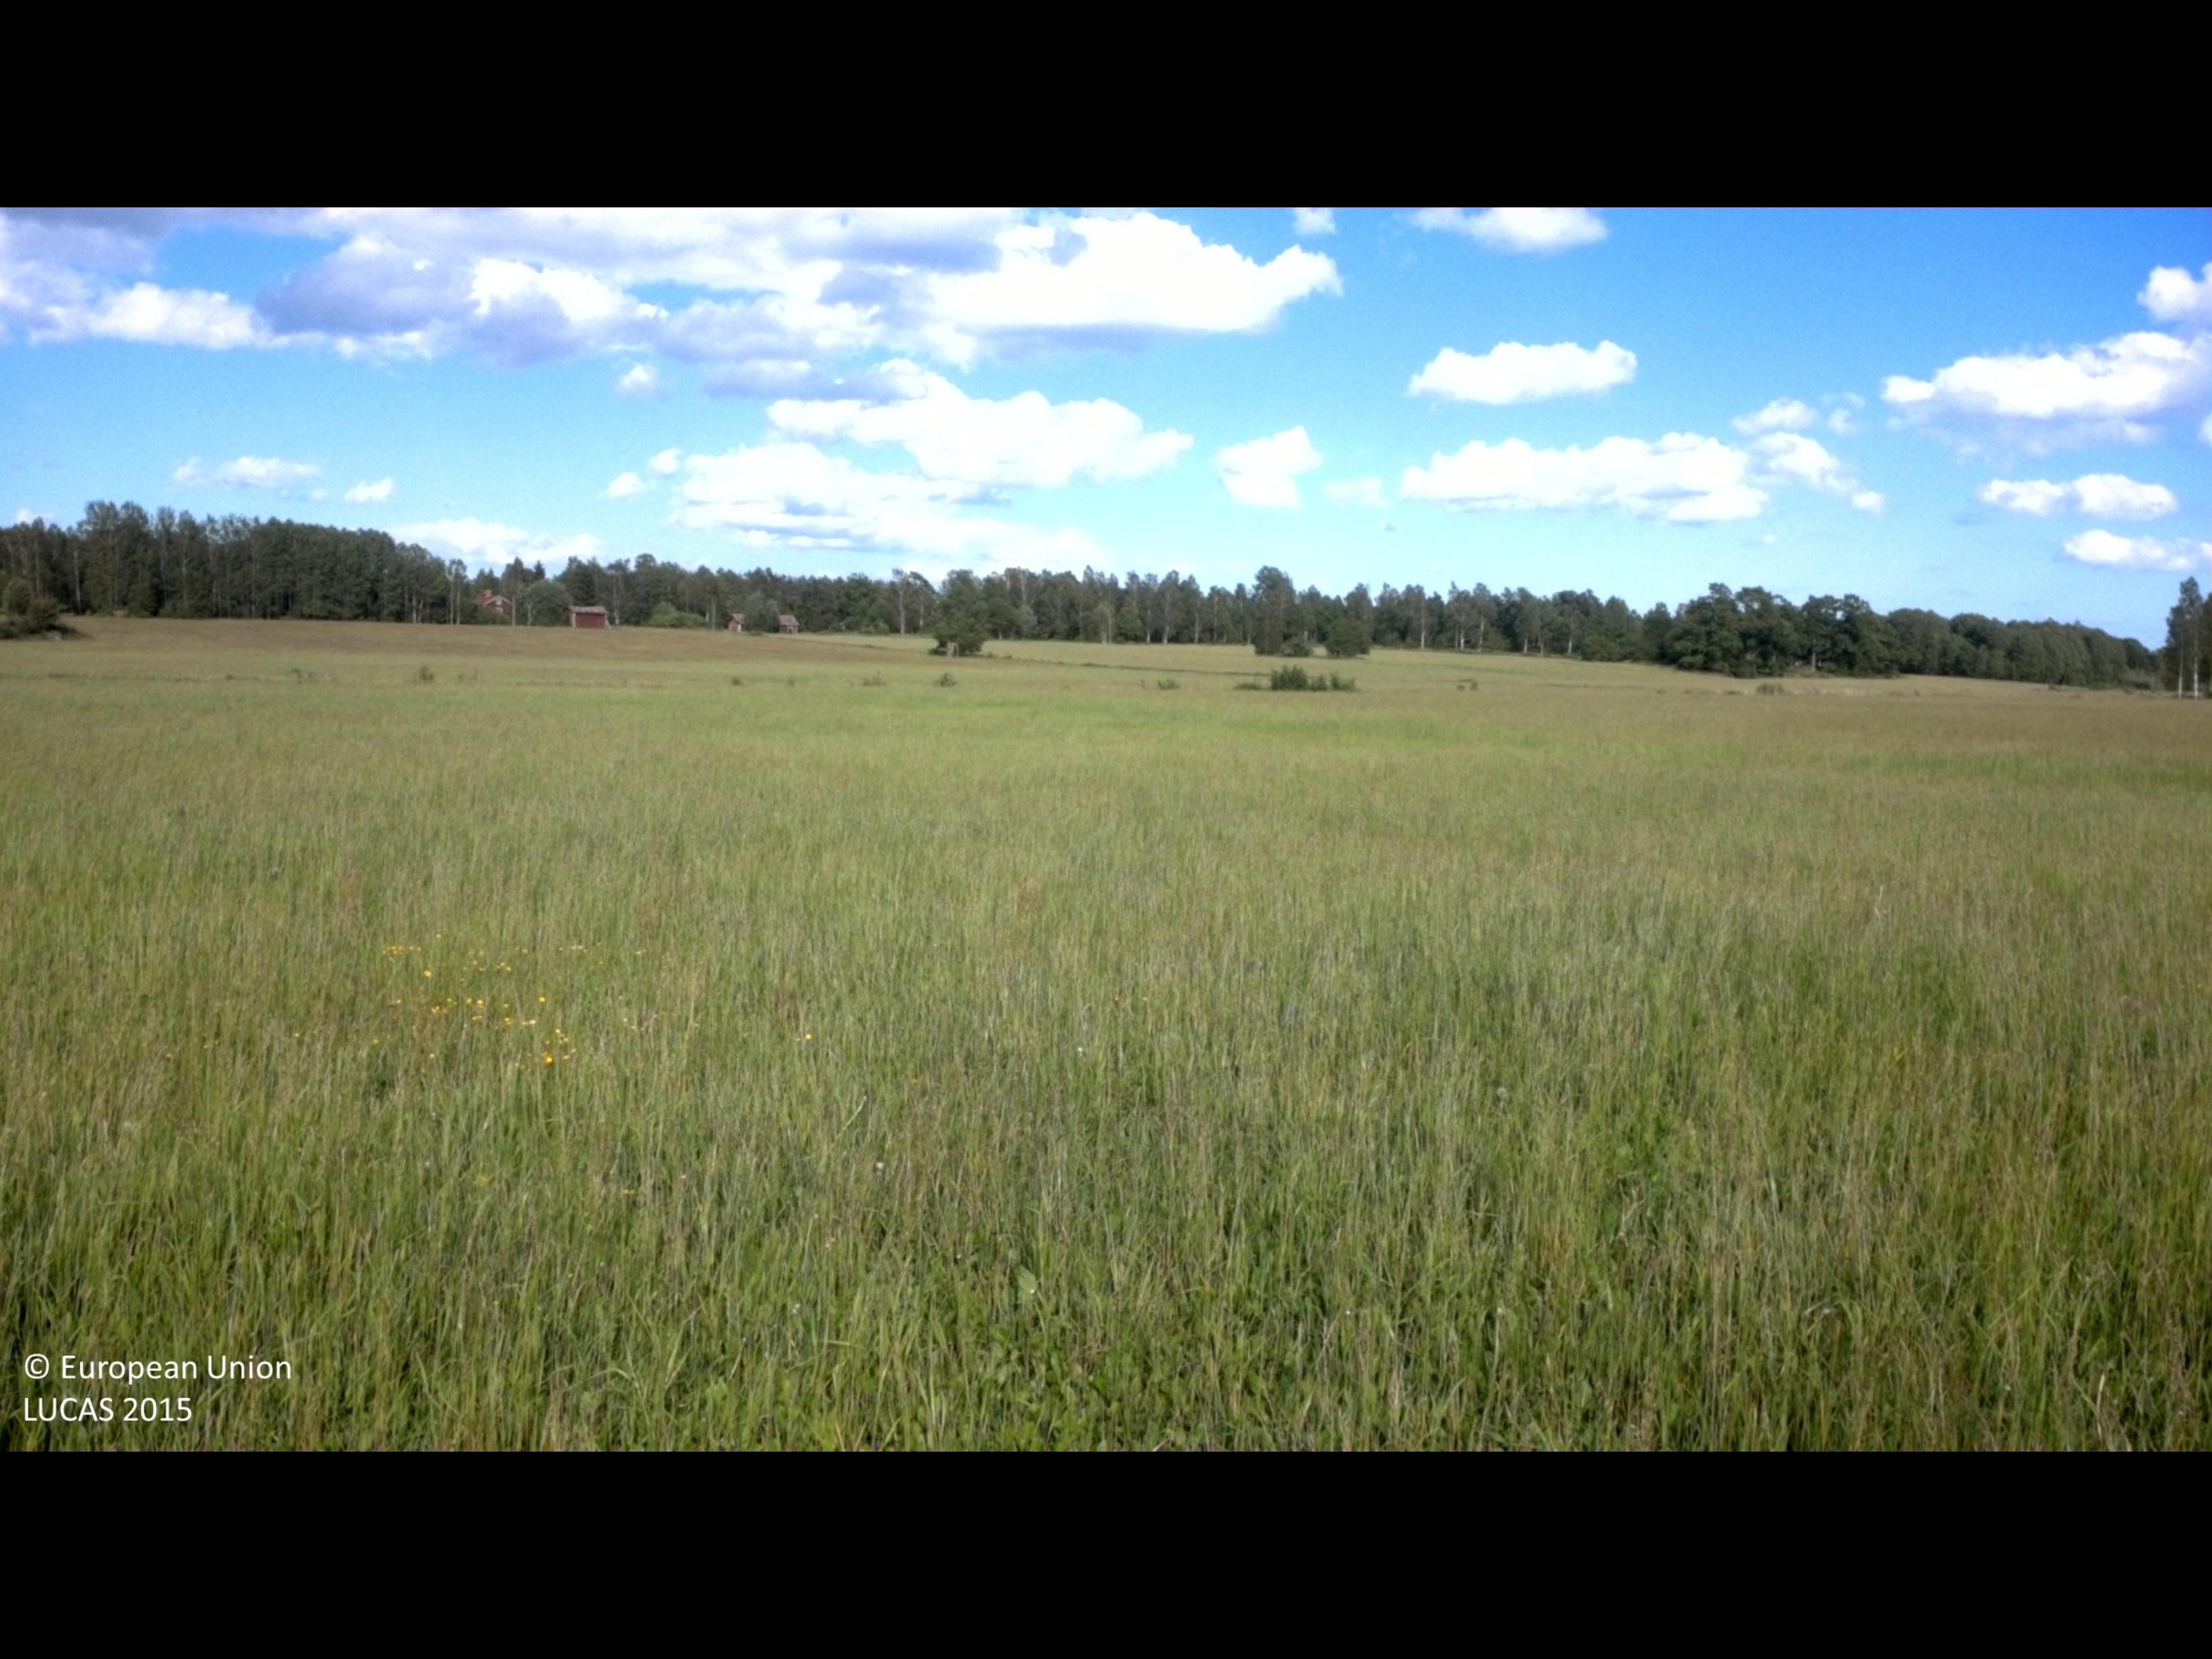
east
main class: Grassland
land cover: Grassland without tree/shrub cover
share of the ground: > 75 %
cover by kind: herbaceous plants 100 %
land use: Agriculture (excluding fallow land and kitchen gardens)
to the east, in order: Grassland without tree/shrub cover; Single bushes/trees; Ditches and canals; Single bushes/trees; Grassland without tree/shrub cover
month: June
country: SE
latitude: 57.7715
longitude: 16.5385
